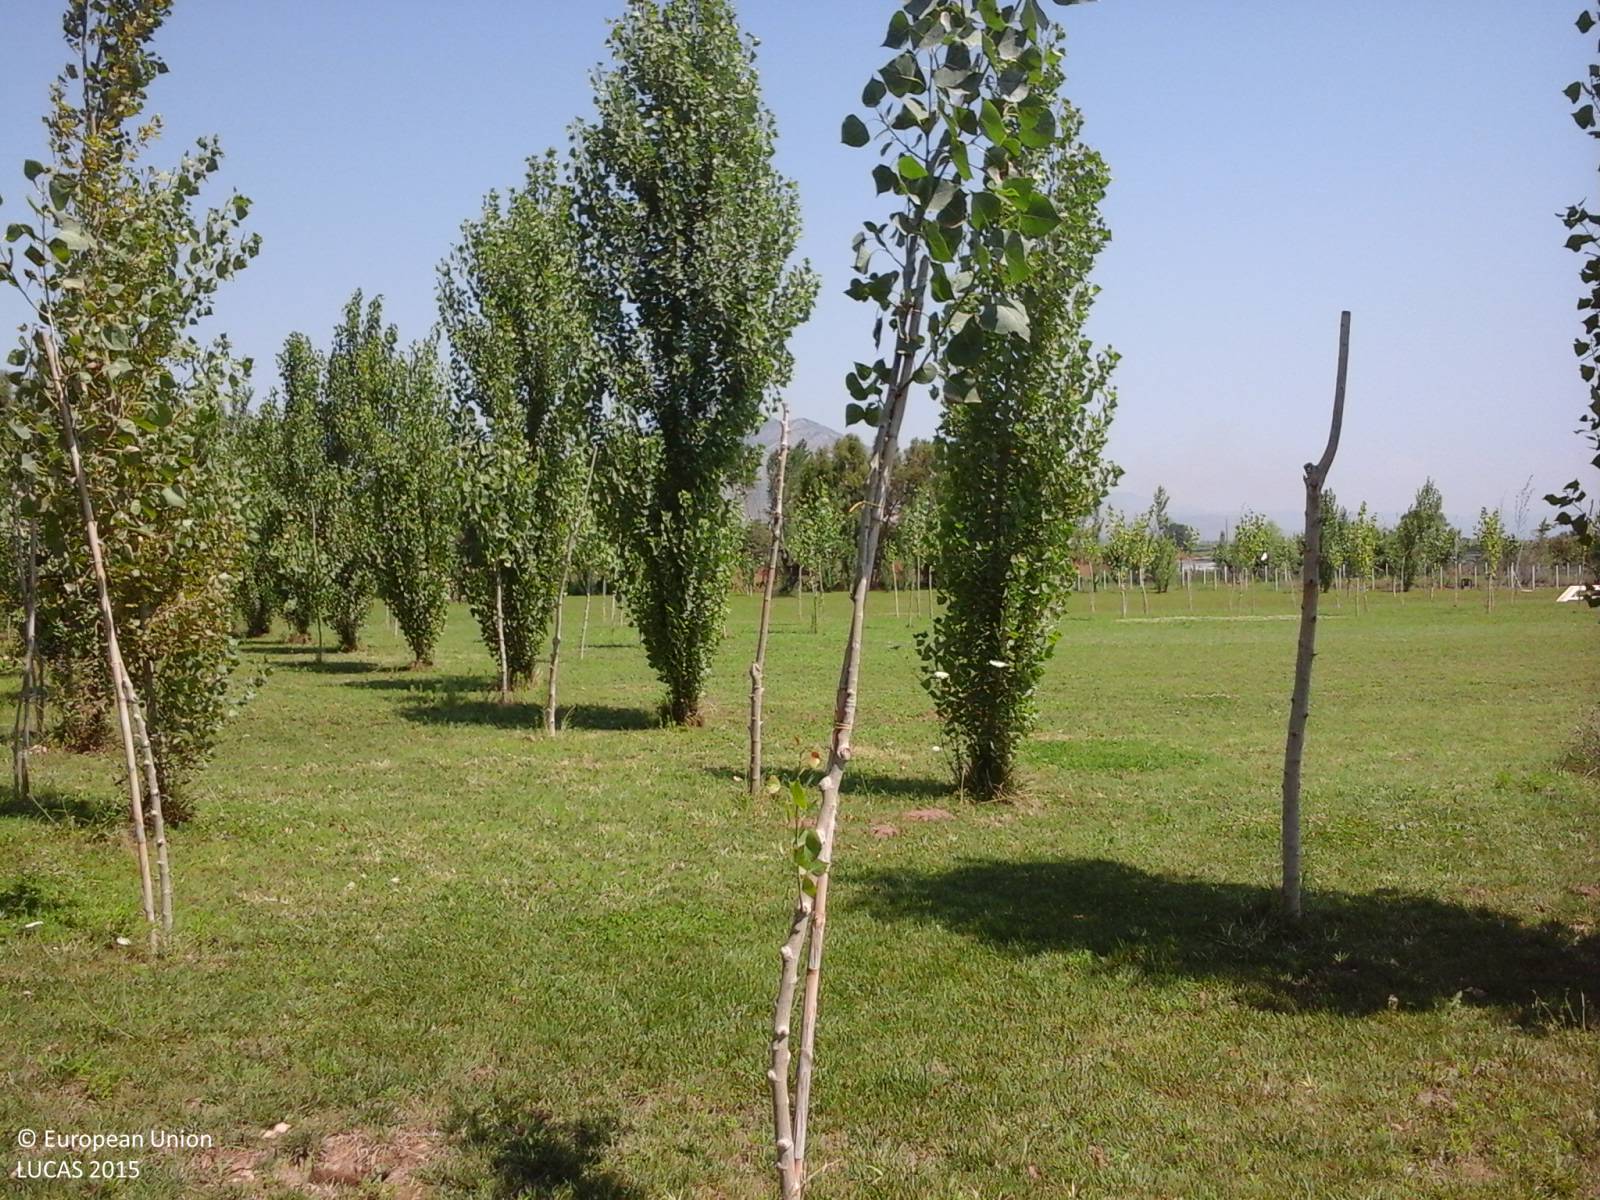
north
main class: Woodland
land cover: Broadleaved woodland
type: non-riverine alder, birch or aspen forest
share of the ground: > 75 %
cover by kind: broadleaved forest trees 70 %, herbaceous plants 30 %
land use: Amenities, museums, leisure
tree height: < 5 m
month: July
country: IT
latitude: 41.0944
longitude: 13.9247
